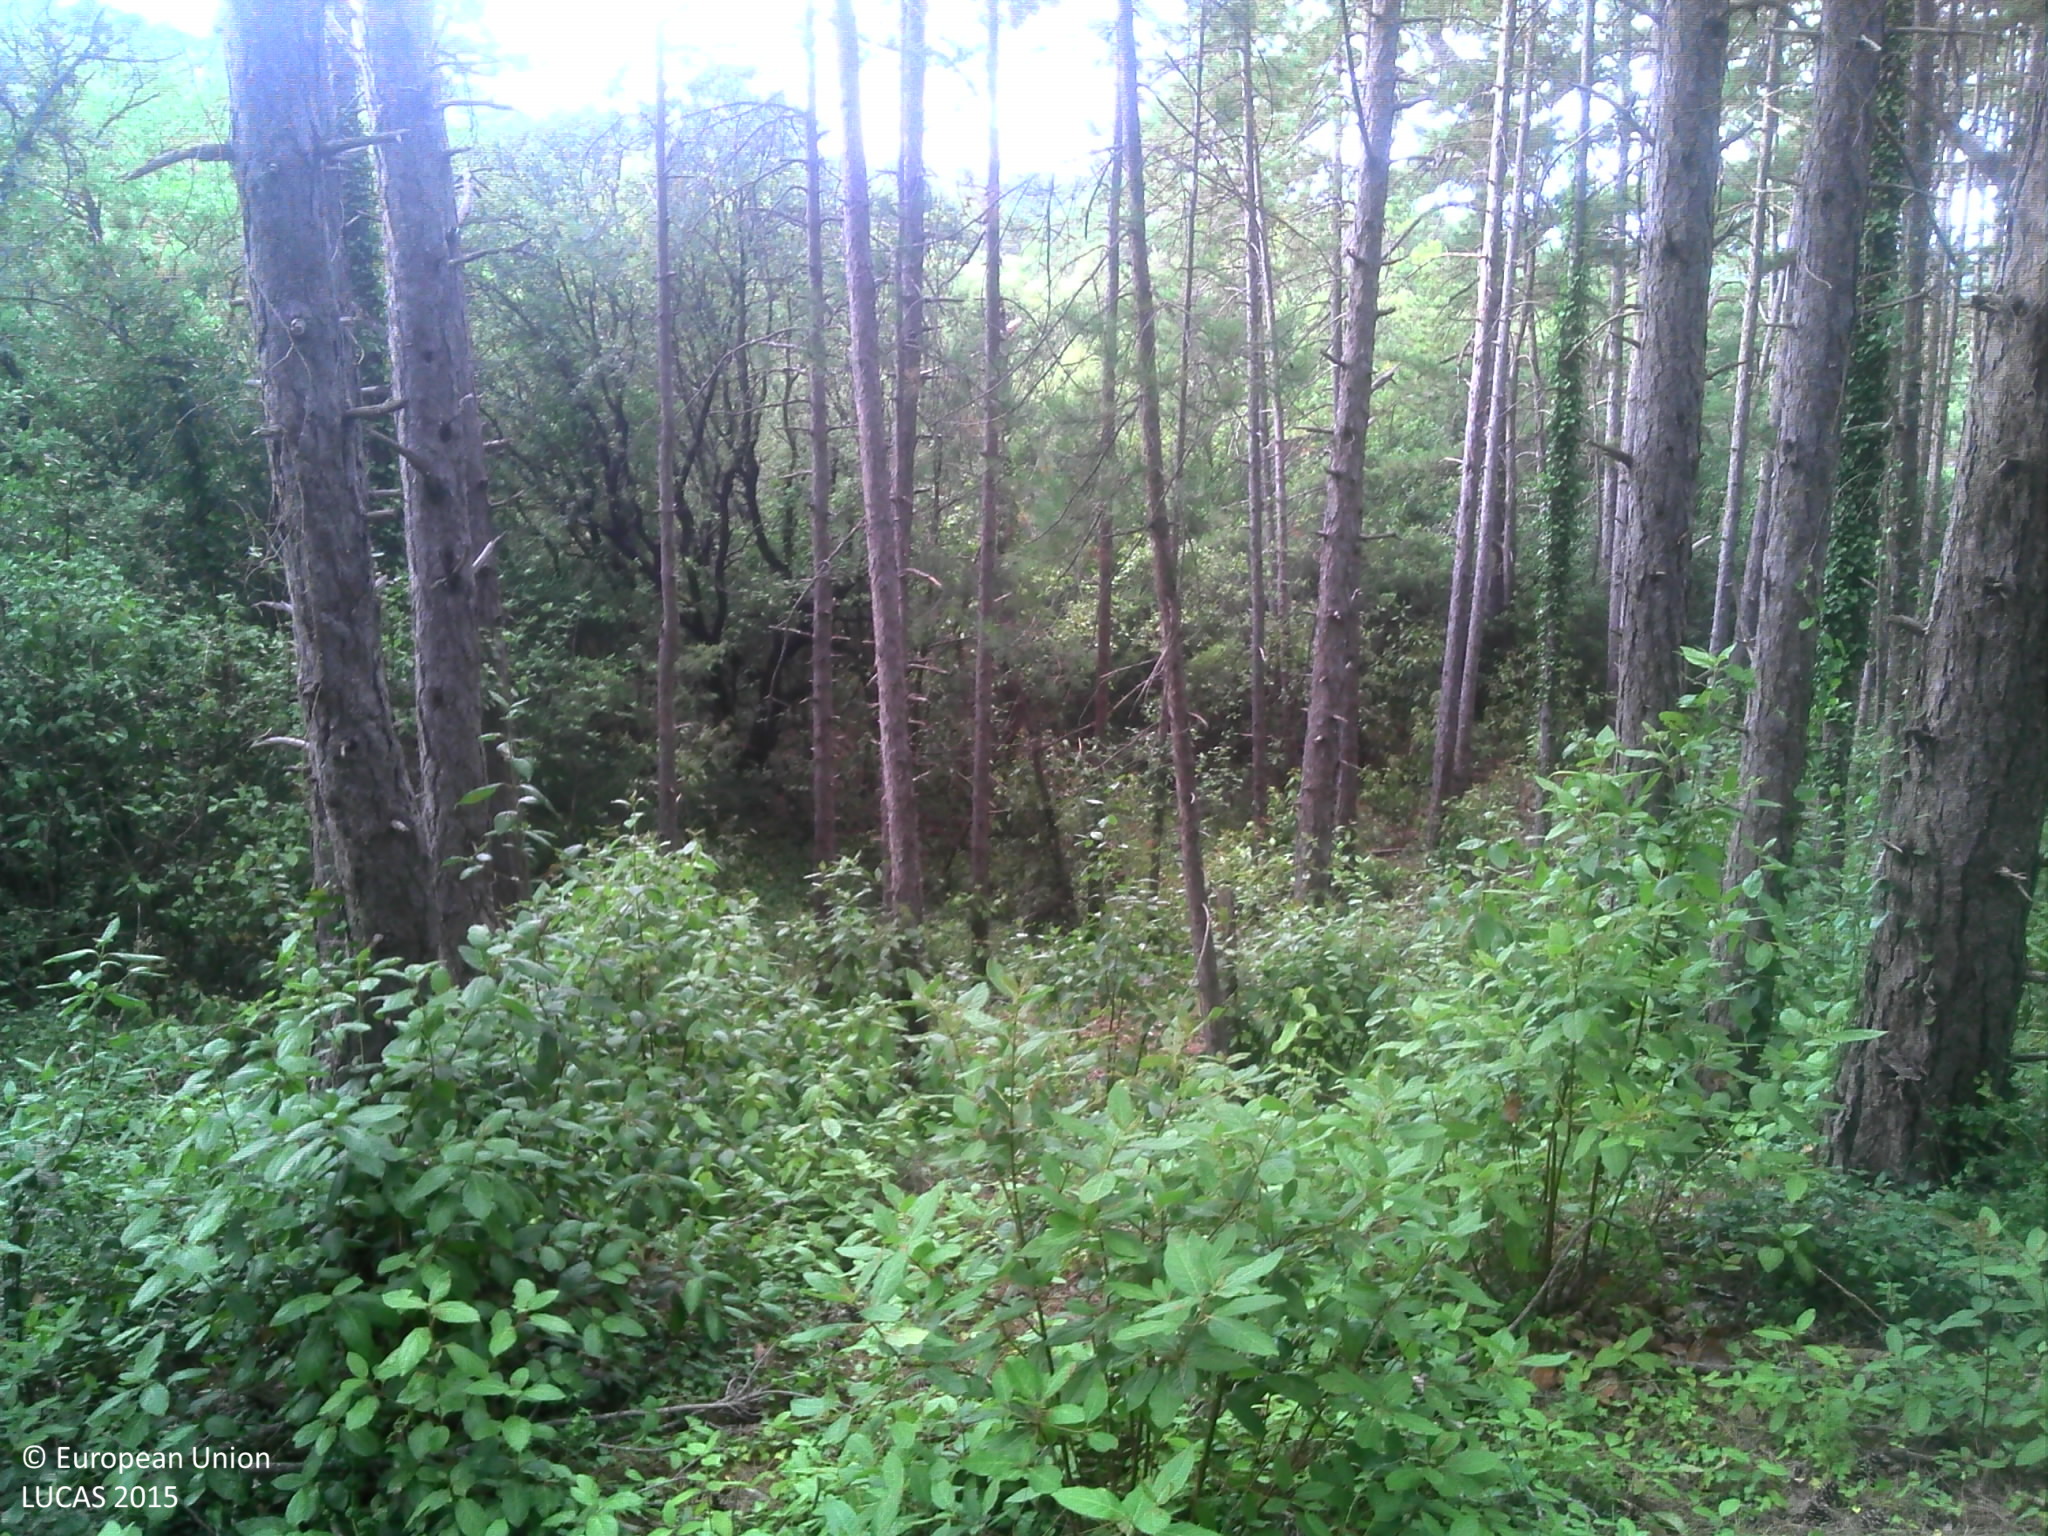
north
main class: Woodland
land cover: Pine dominated coniferous woodland
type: coniferous forest of the mediterranean region
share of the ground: > 75 %
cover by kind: coniferous forest trees 90 %, herbaceous plants 10 %
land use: Semi-natural and natural areas not in use
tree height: > 5 m
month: July
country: FR
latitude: 44.3918
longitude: 4.6215
